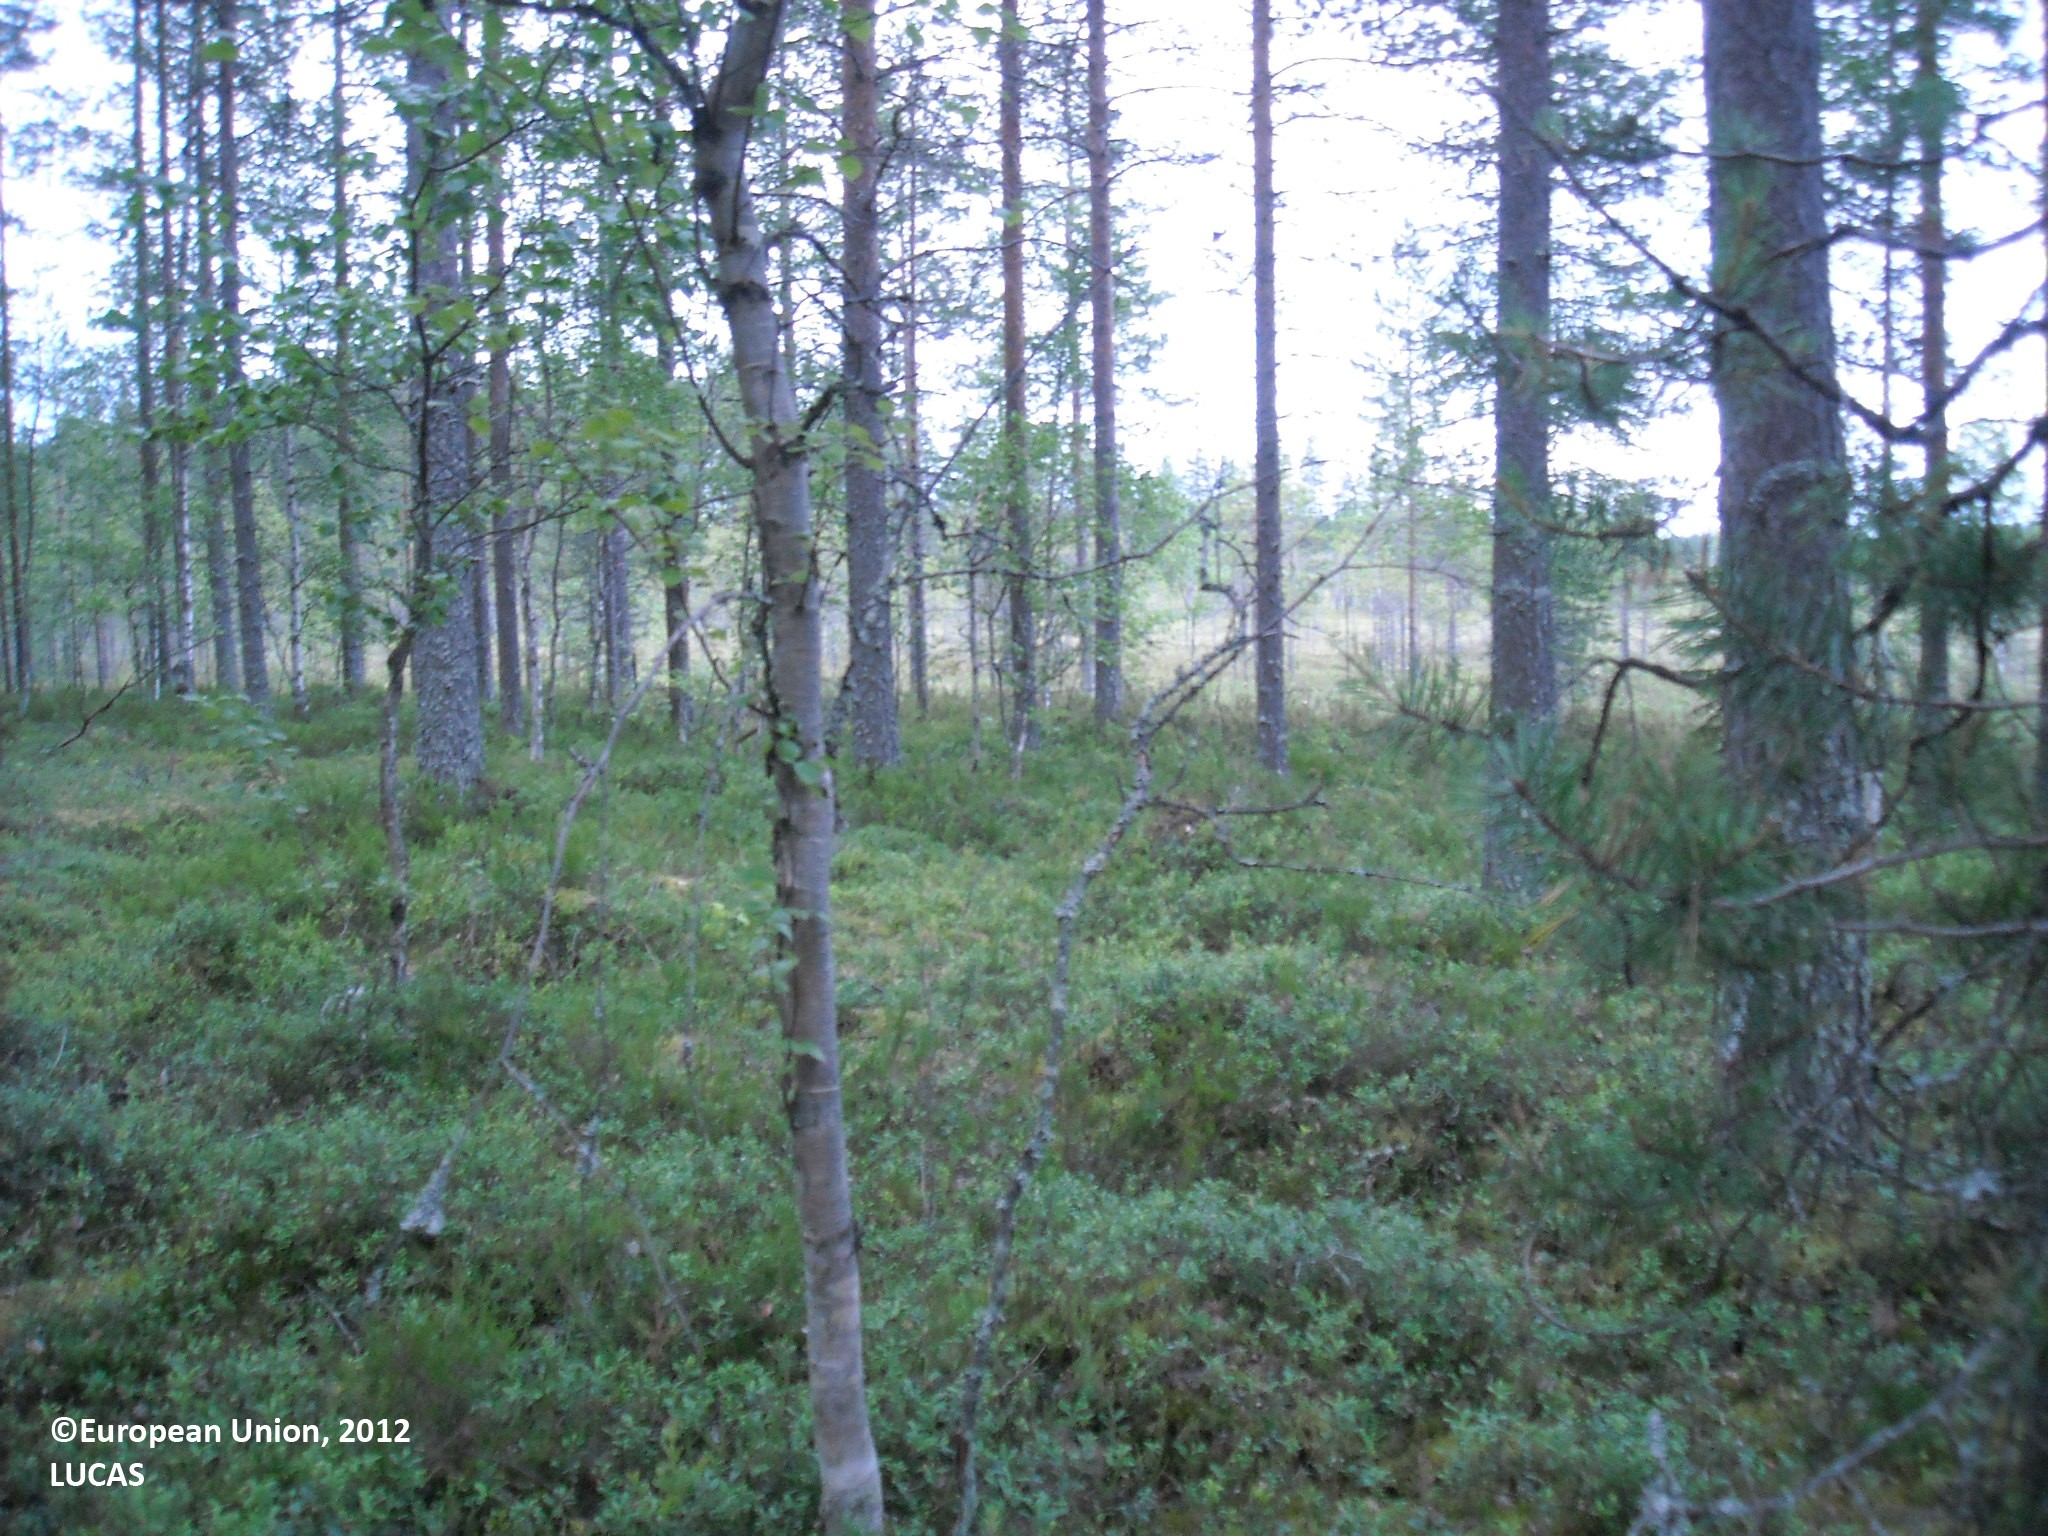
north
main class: Woodland
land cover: Pine dominated coniferous woodland
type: boreal forest
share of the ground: > 75 %
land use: Forestry
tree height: > 5 m
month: July
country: FI
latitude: 65.0440
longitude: 26.7026
